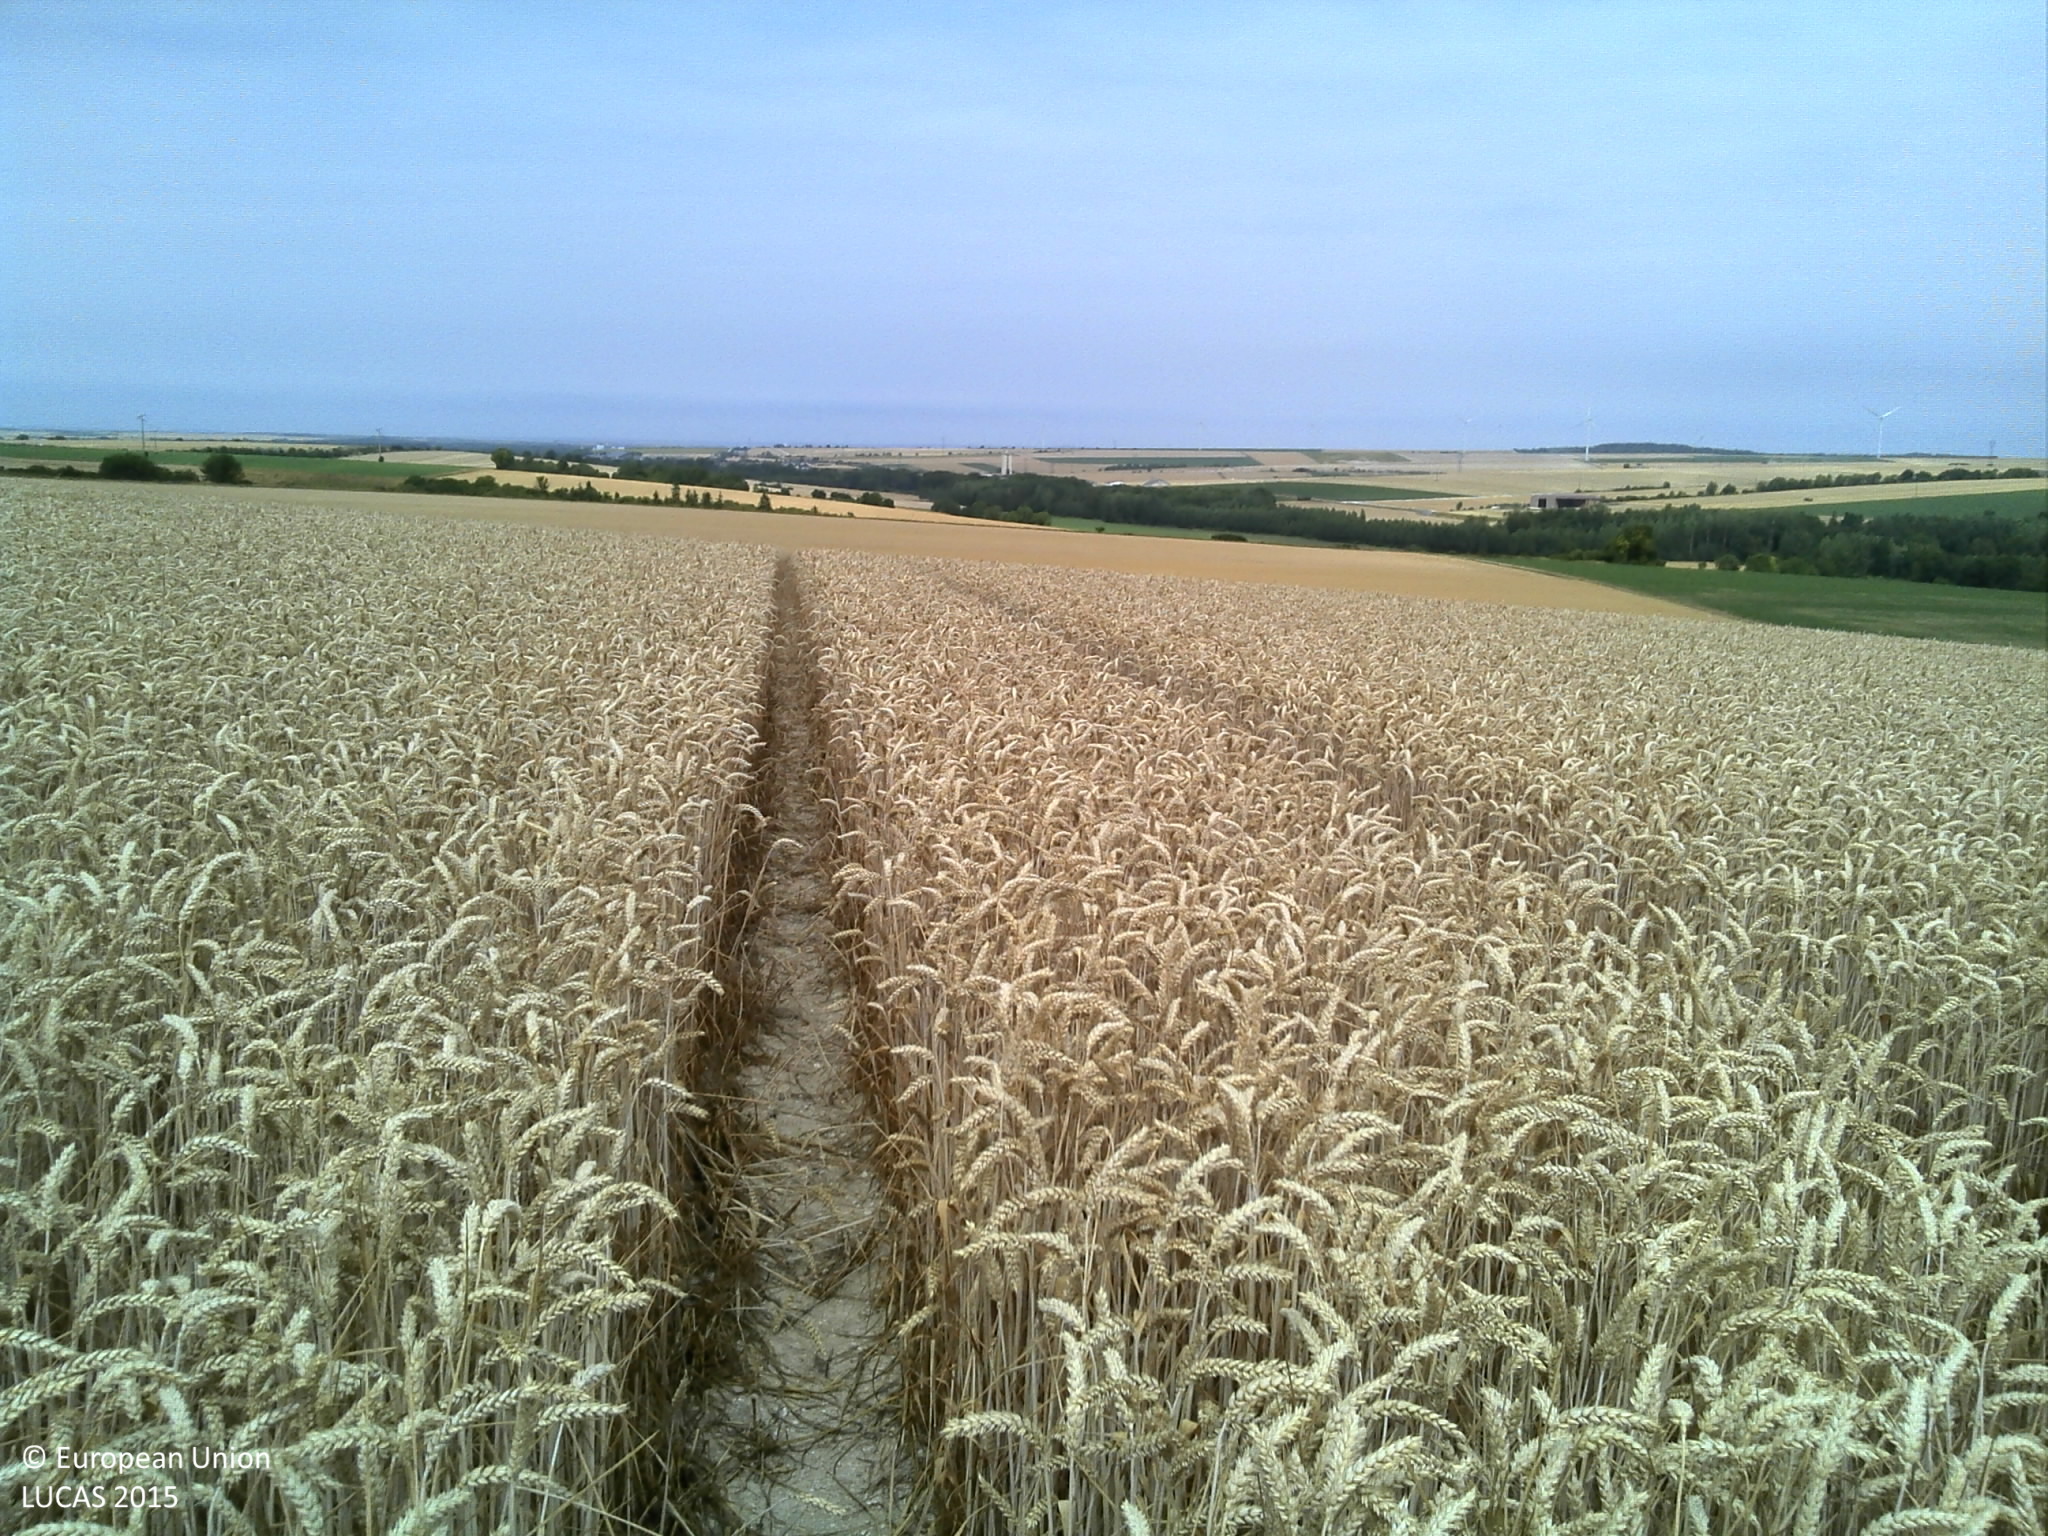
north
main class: Cropland
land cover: Common wheat
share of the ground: > 75 %
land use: Agriculture (excluding fallow land and kitchen gardens)
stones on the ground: < 10 %
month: July
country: FR
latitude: 48.8108
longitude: 4.5637
